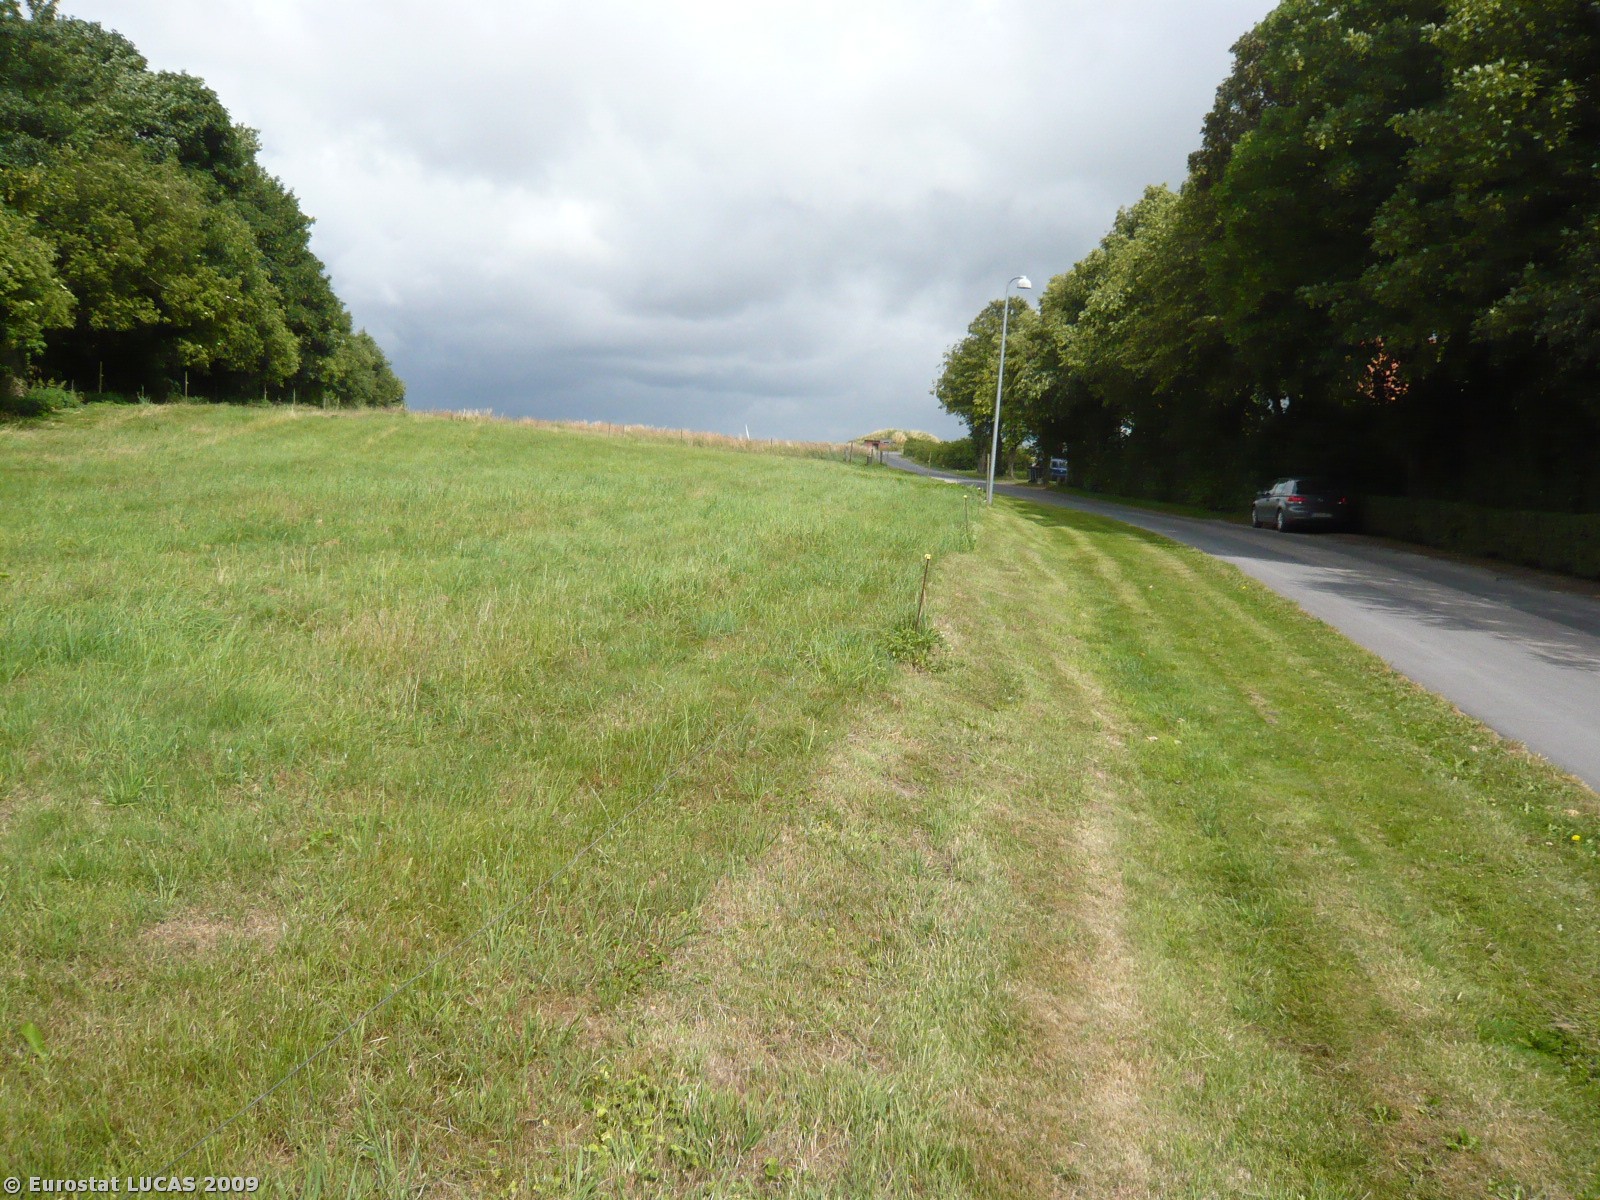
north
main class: Grassland
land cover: Grassland without tree/shrub cover
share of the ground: > 75 %
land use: Agriculture (excluding fallow land and kitchen gardens)
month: July
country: DK
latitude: 55.3538
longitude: 11.3395
